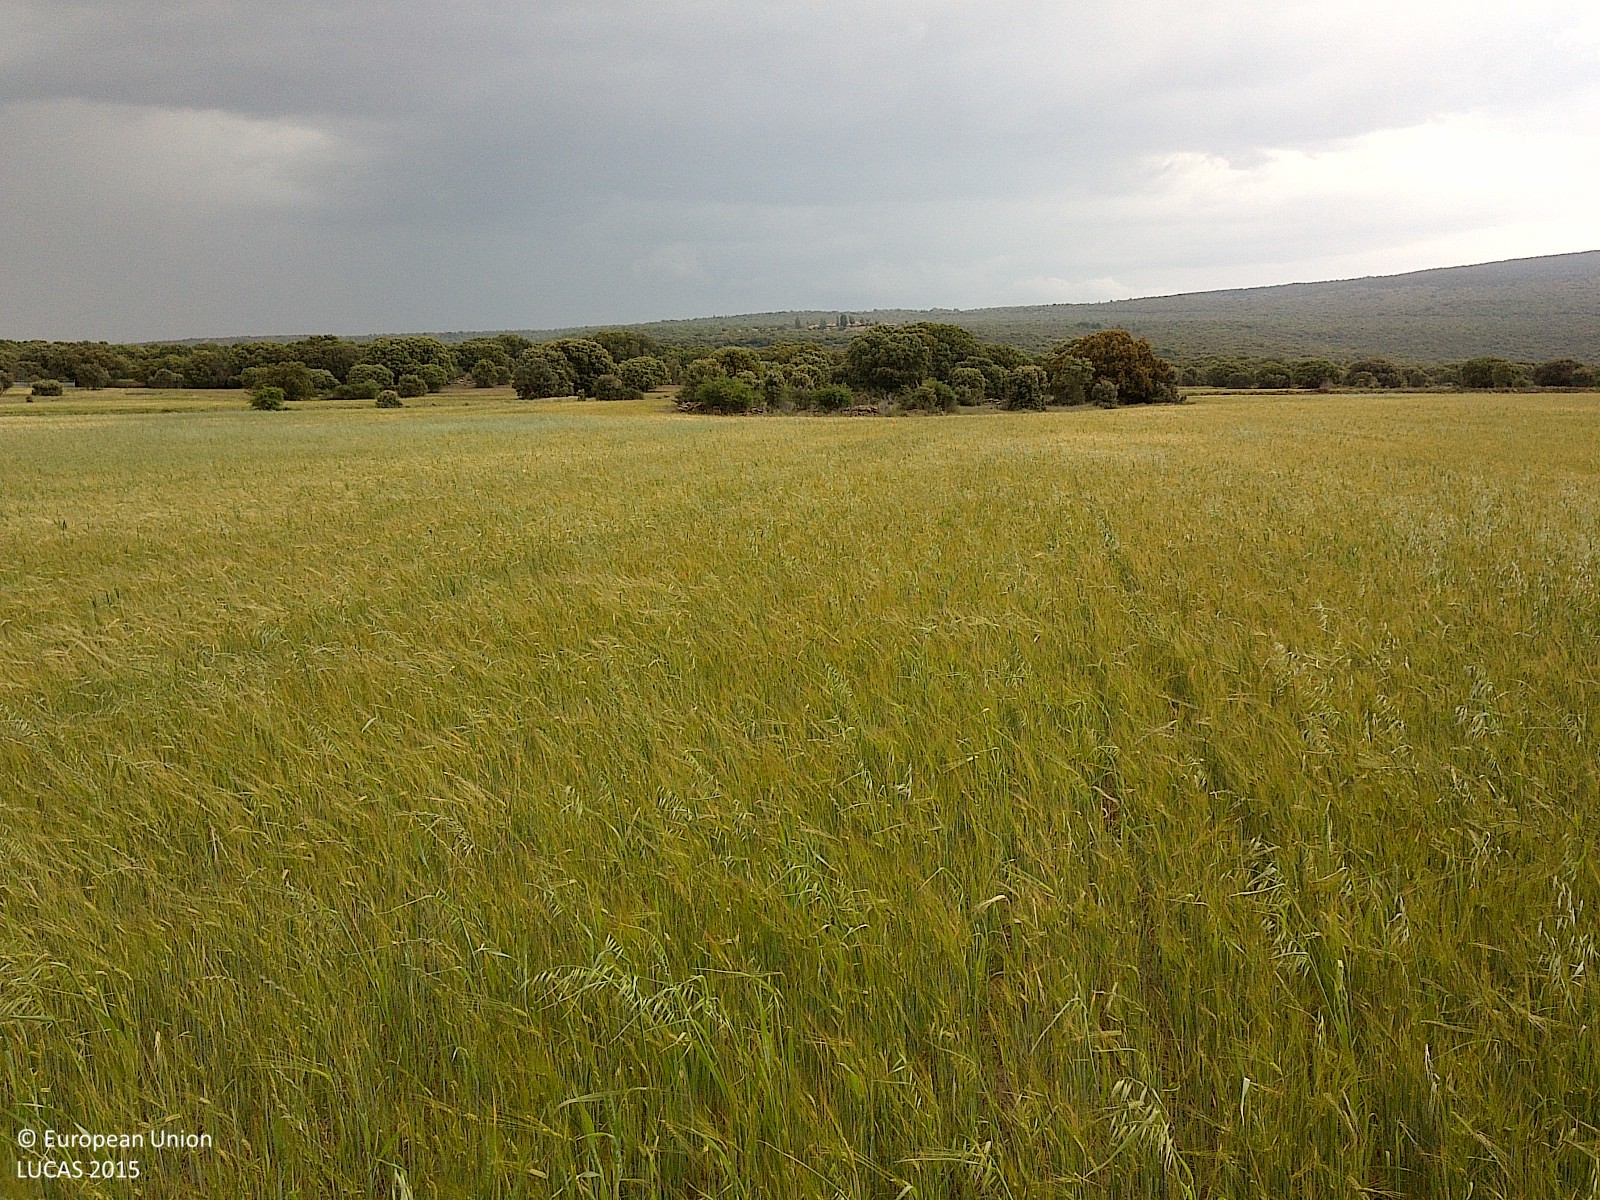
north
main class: Cropland
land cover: Barley
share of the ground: > 75 %
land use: Agriculture (excluding fallow land and kitchen gardens)
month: May
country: ES
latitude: 41.8097
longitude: -2.3023
